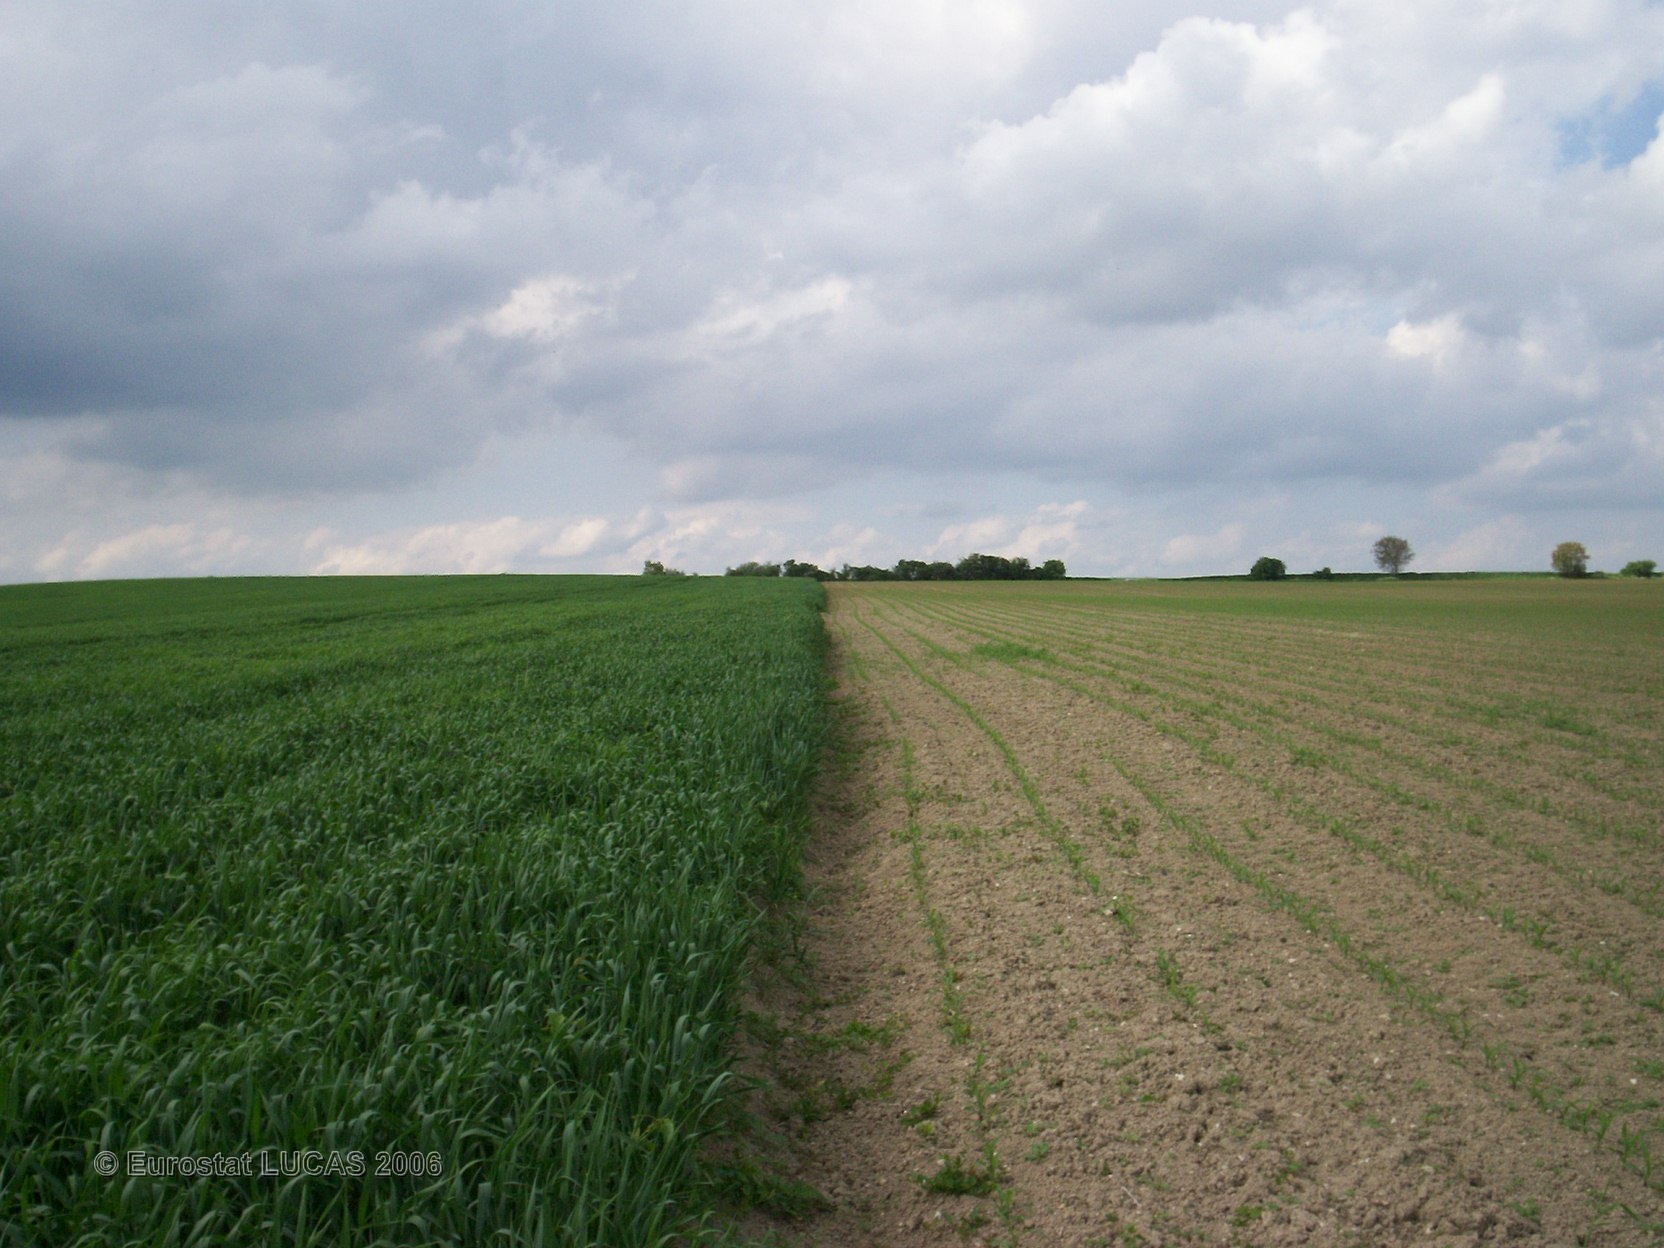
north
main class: Cropland
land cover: Maize
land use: Agriculture (excluding fallow land and kitchen gardens)
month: May
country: FR
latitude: 49.5763
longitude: 4.3672
